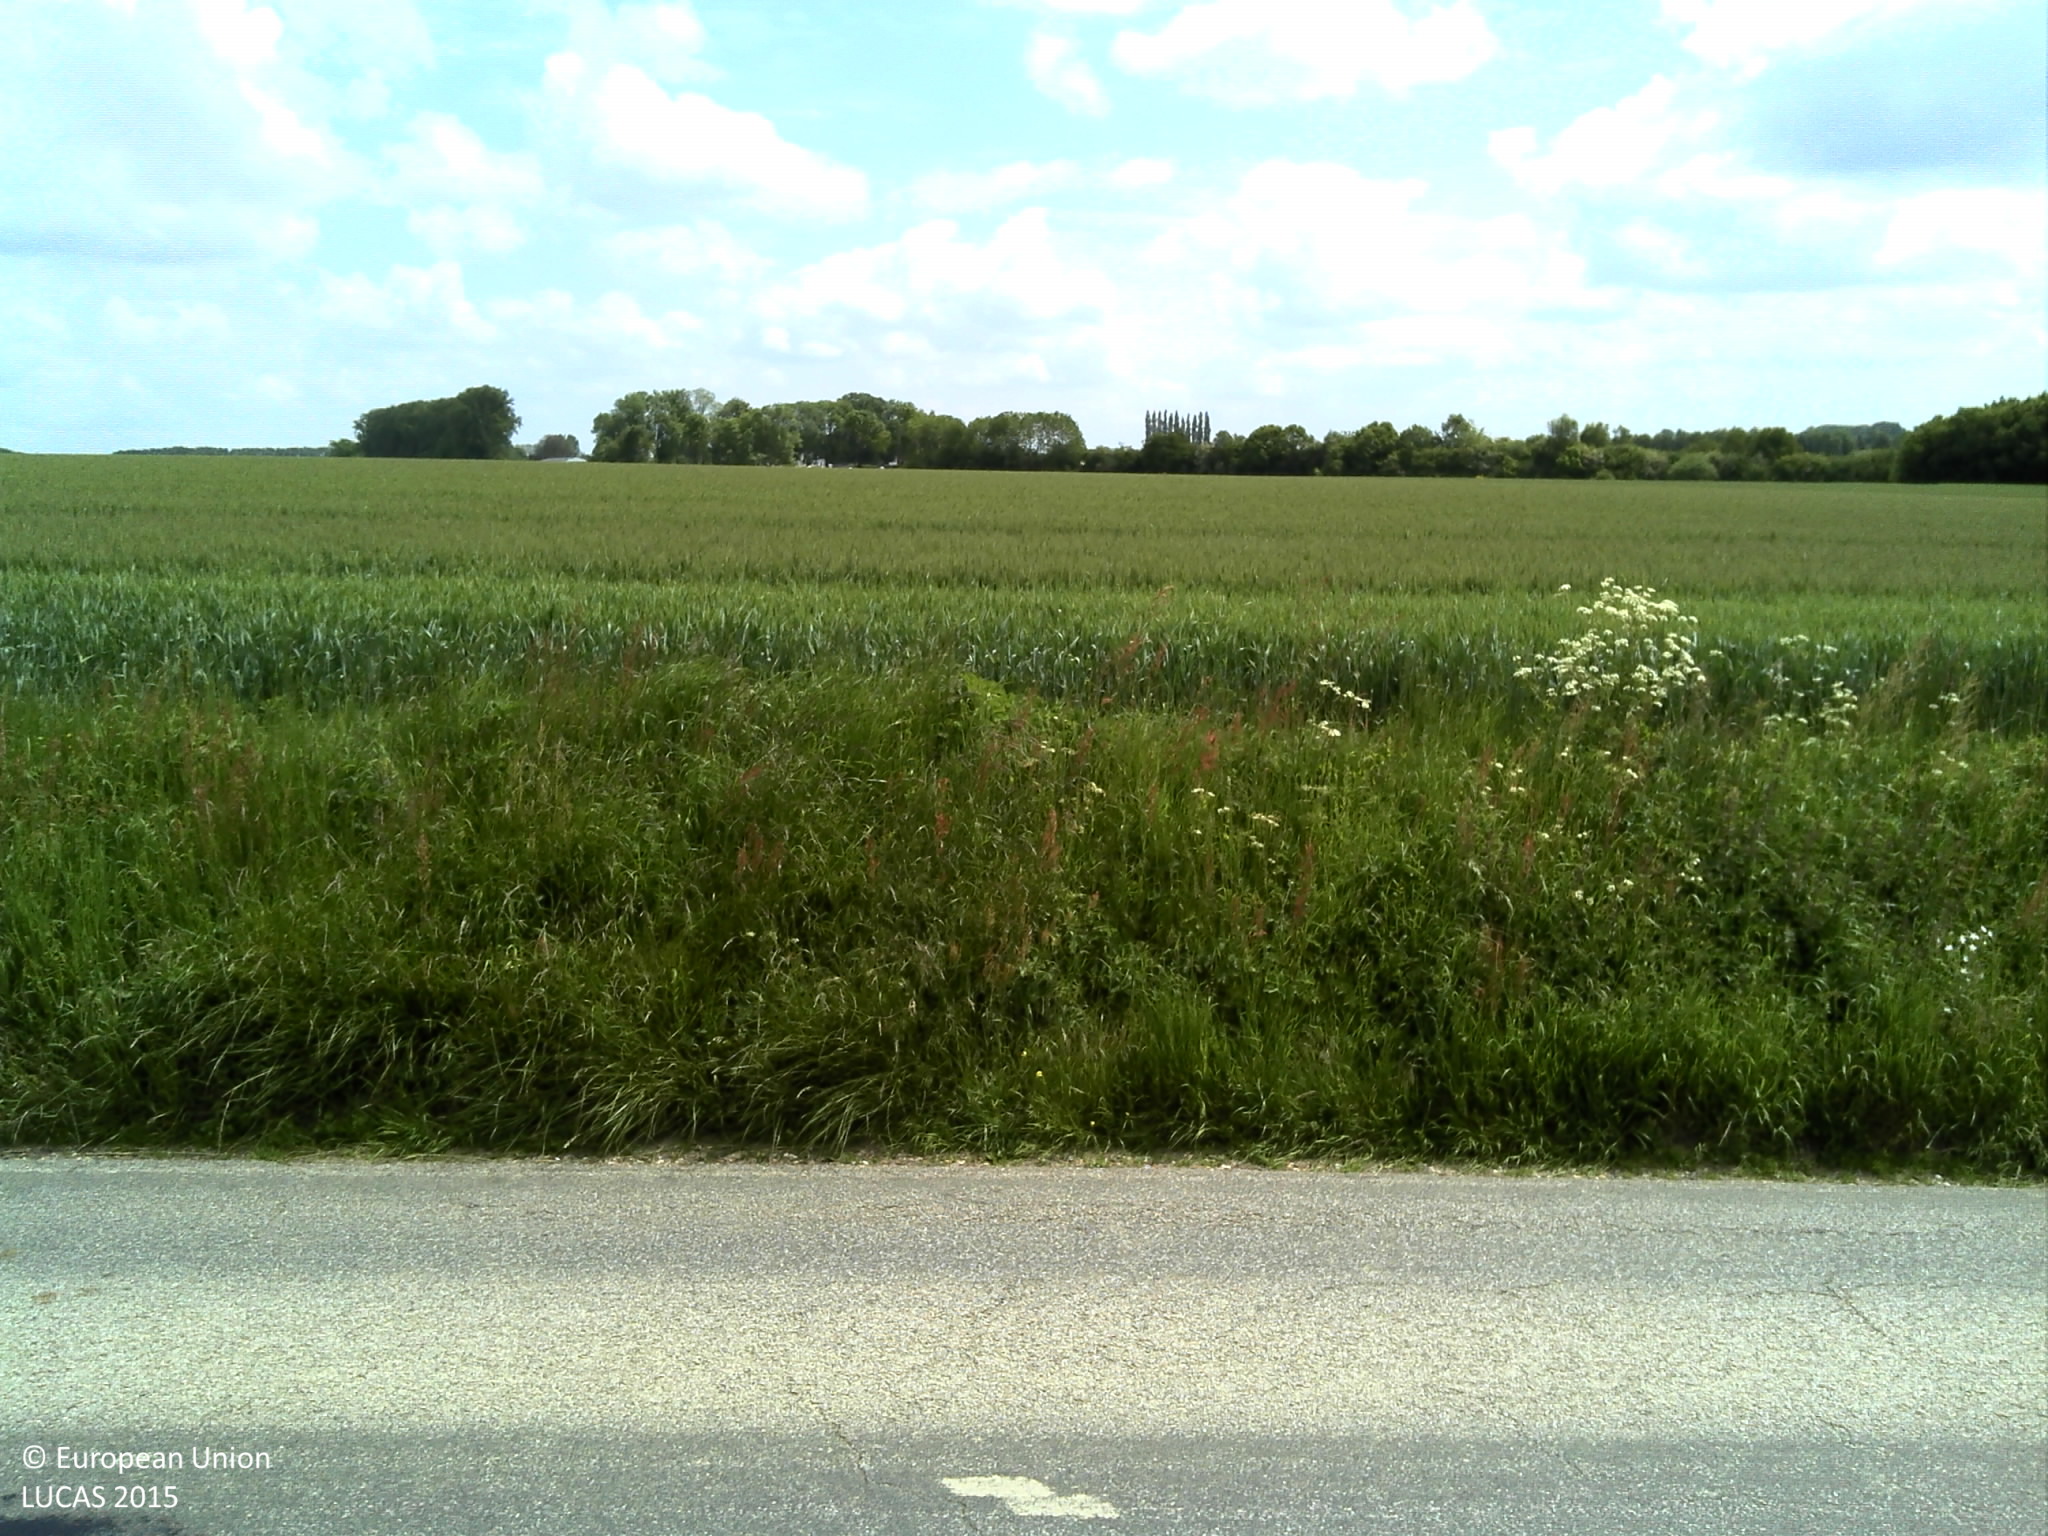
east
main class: Cropland
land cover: Rape and turnip rape
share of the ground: > 75 %
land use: Agriculture (excluding fallow land and kitchen gardens)
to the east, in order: Rape and turnip rape; Grass margins; Paved roads, cycling and walking lanes; Grass margins; Durum wheat
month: May
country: FR
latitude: 49.5341
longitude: 1.1772
